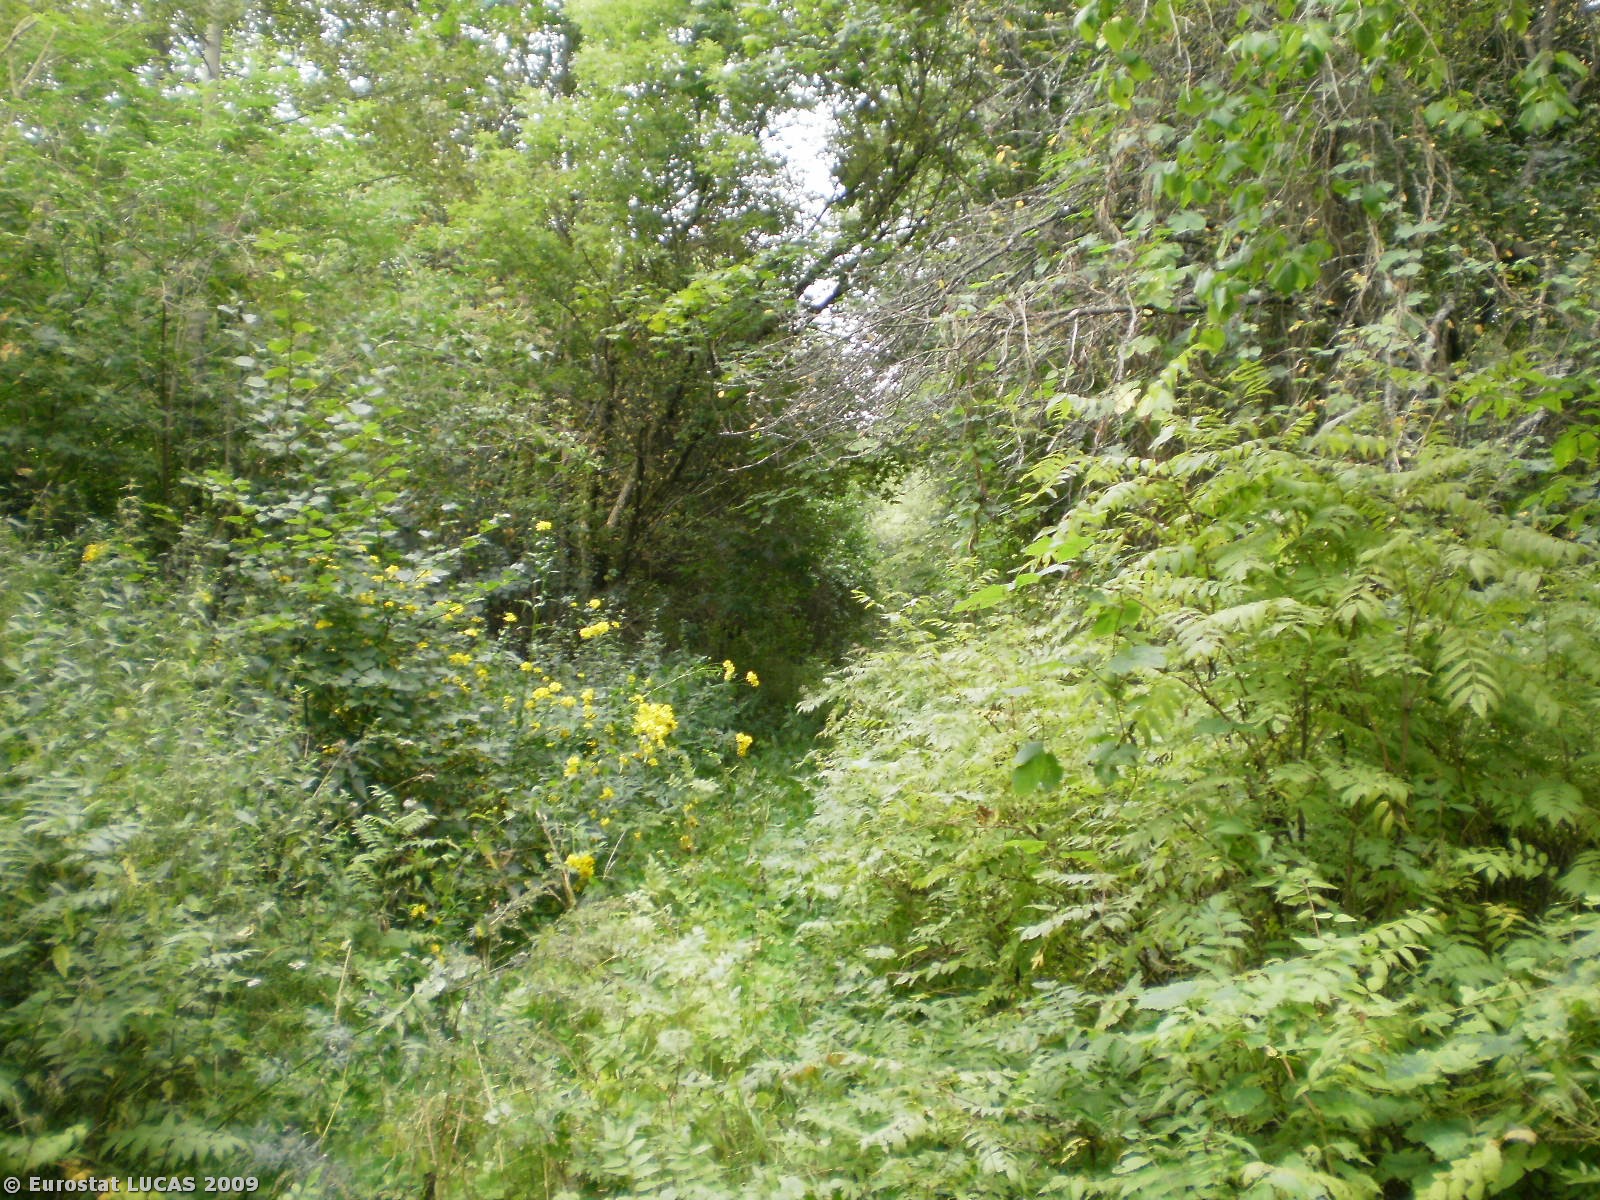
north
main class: Woodland
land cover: Broadleaved woodland
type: mire and swamp forests
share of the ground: > 75 %
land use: Forestry
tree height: > 5 m
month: August
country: PL
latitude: 53.5693
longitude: 21.9709
